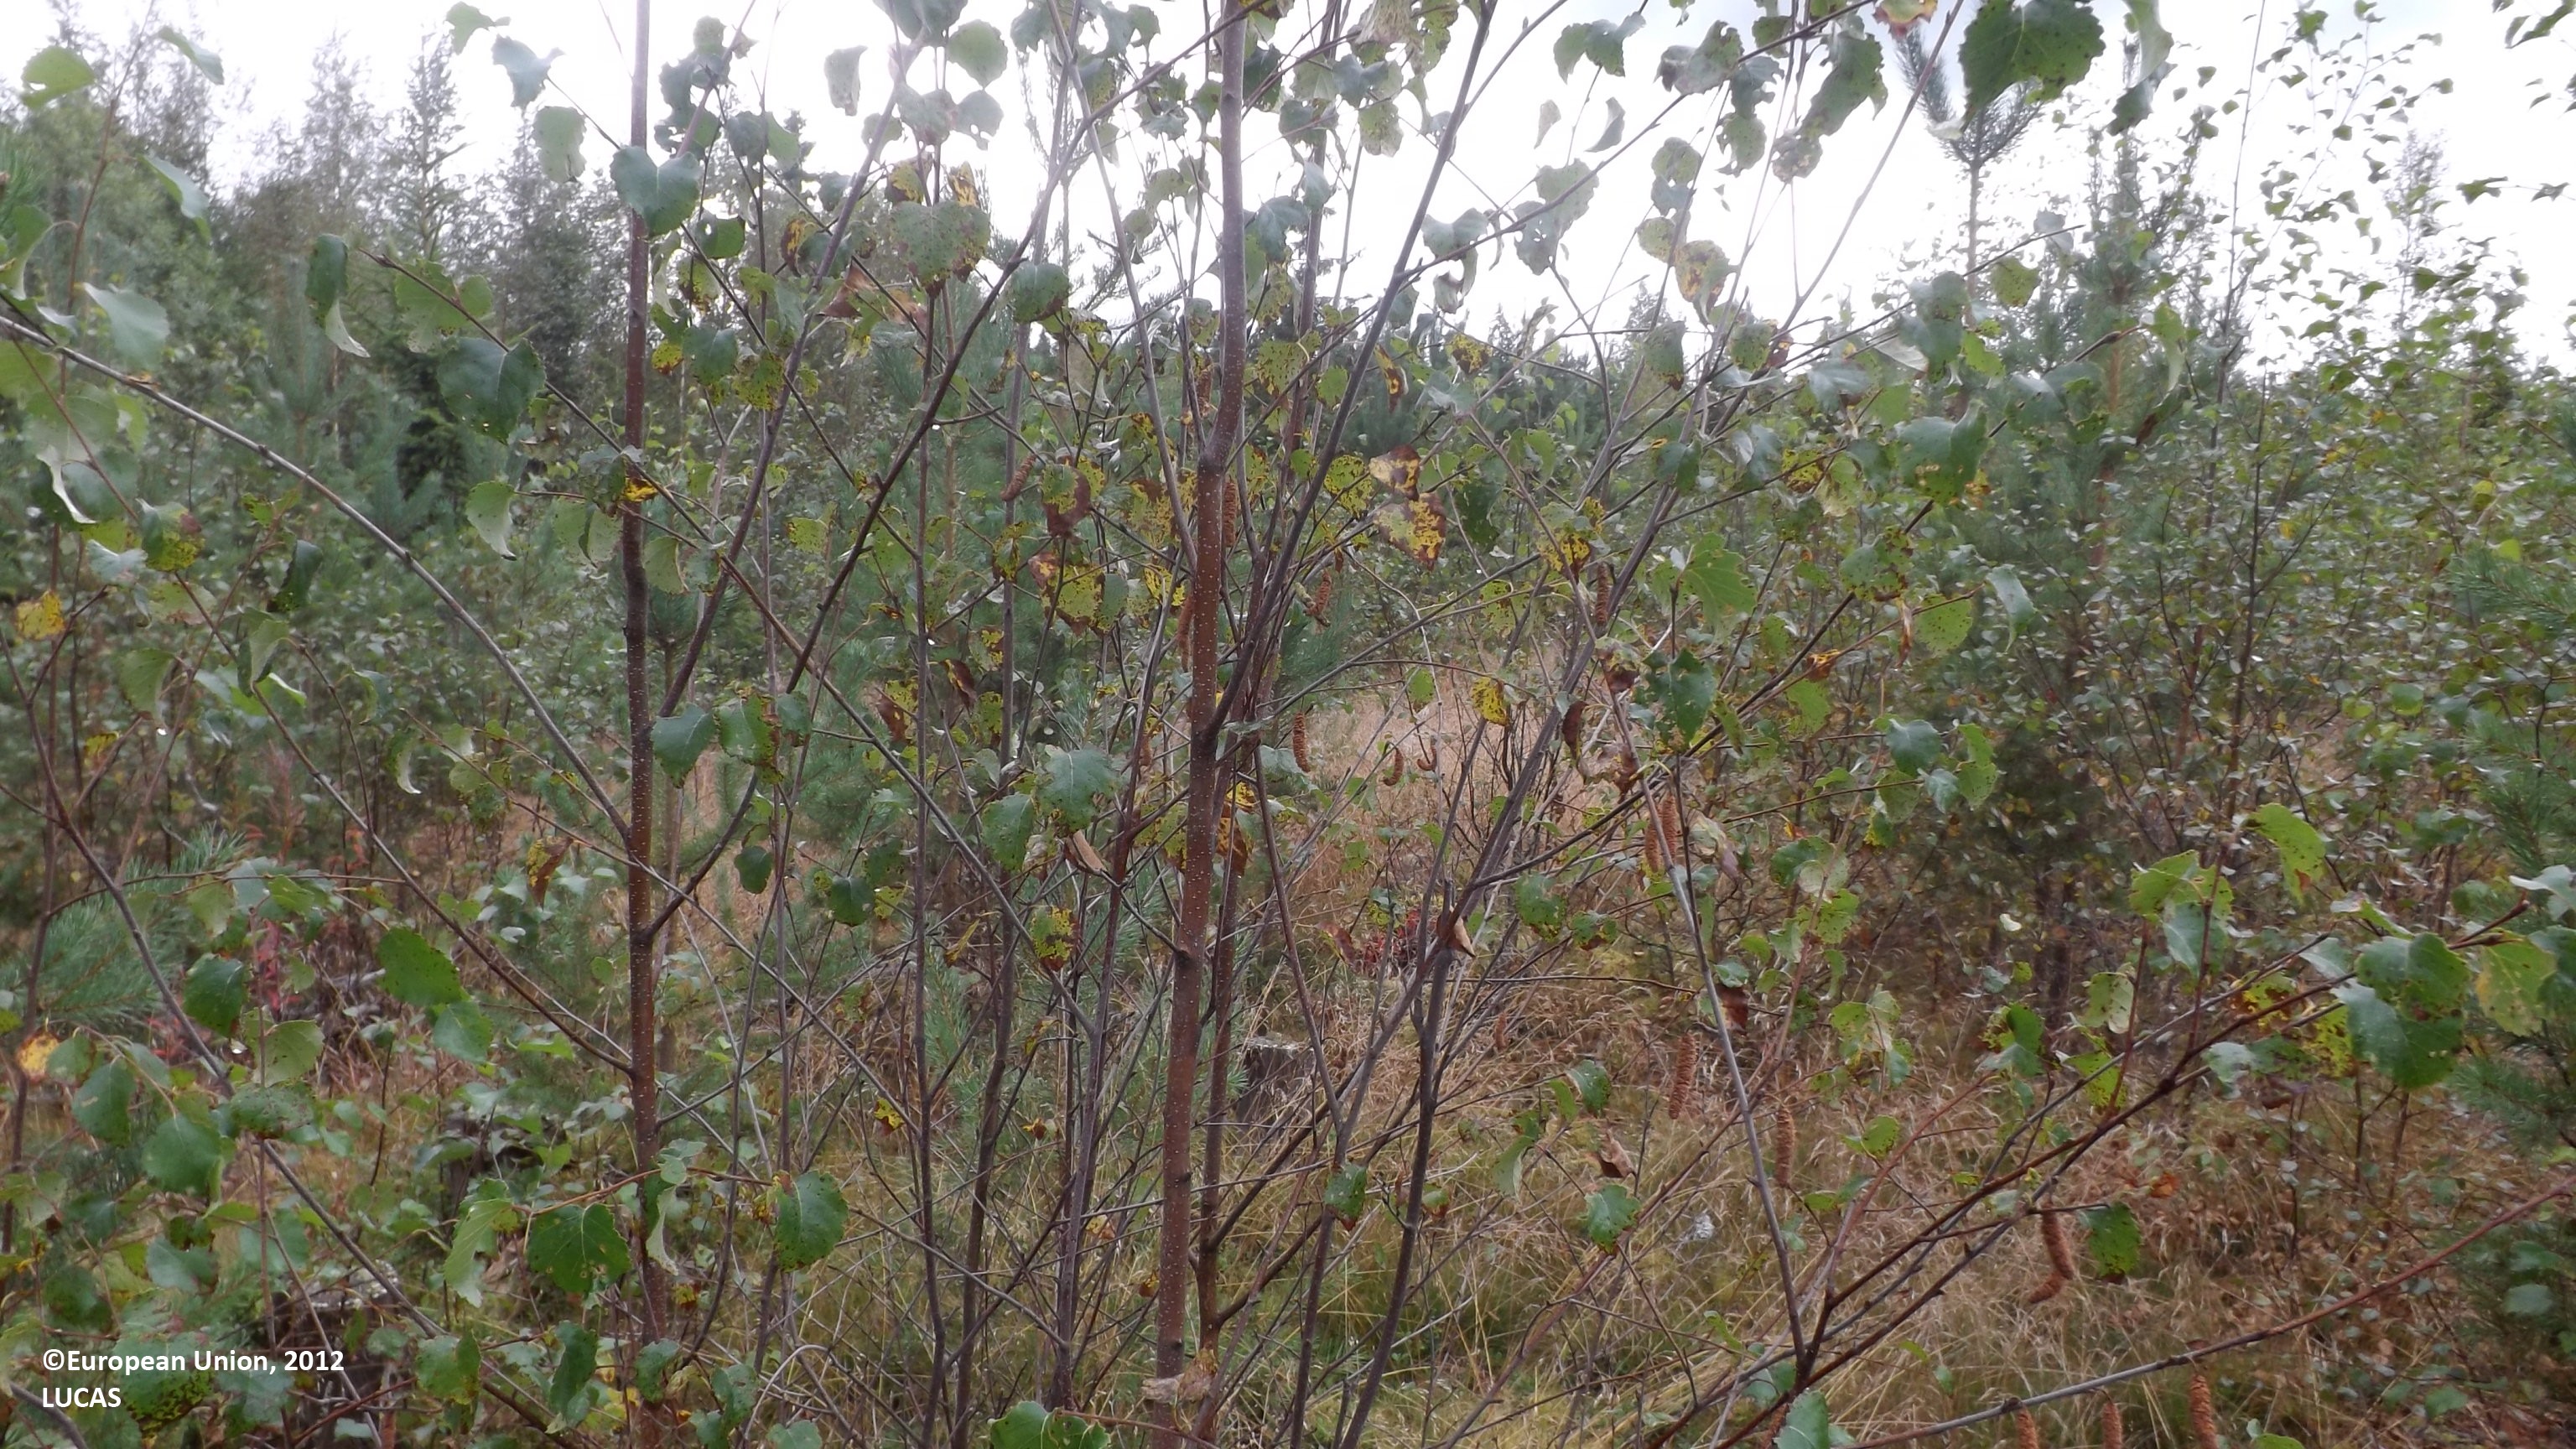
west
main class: Woodland
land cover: Pine dominated mixed woodland
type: boreal forest
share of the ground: 25 - 50 %
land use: Forestry
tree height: < 5 m
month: August
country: FI
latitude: 63.9499
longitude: 23.8809
